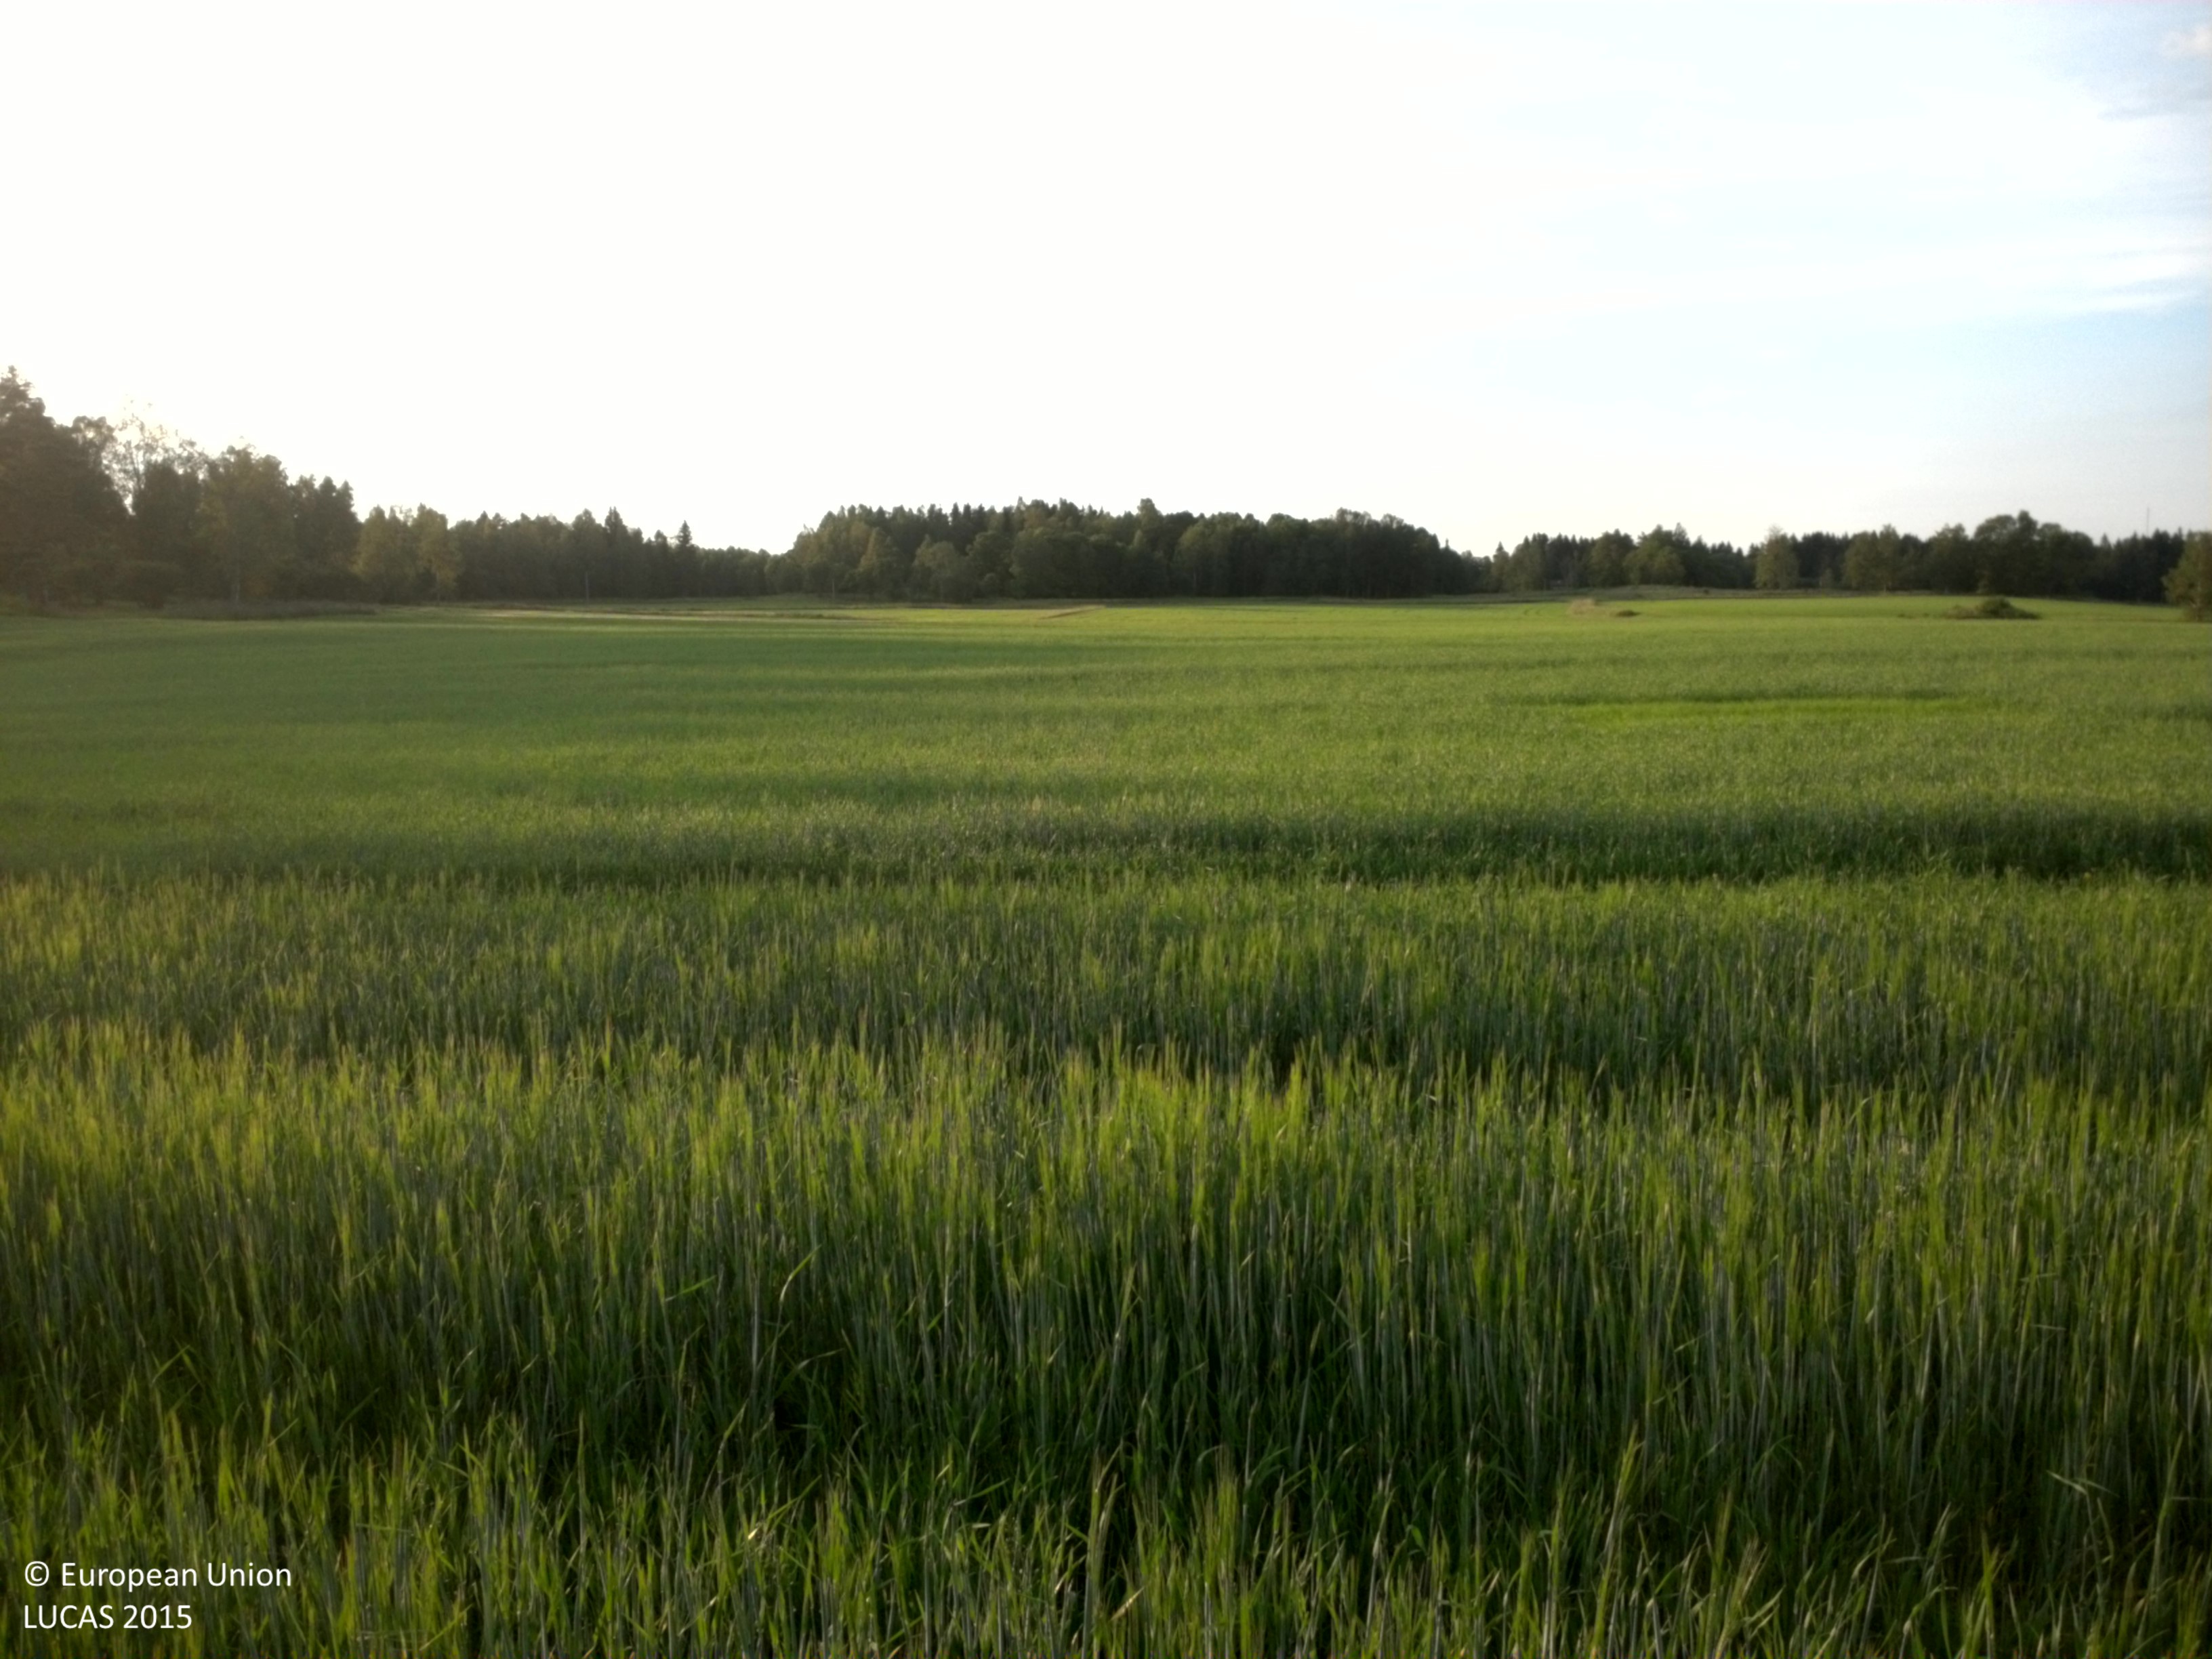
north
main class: Cropland
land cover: Barley
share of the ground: > 75 %
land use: Agriculture (excluding fallow land and kitchen gardens)
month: July
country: SE
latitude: 59.3311
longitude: 14.5789
